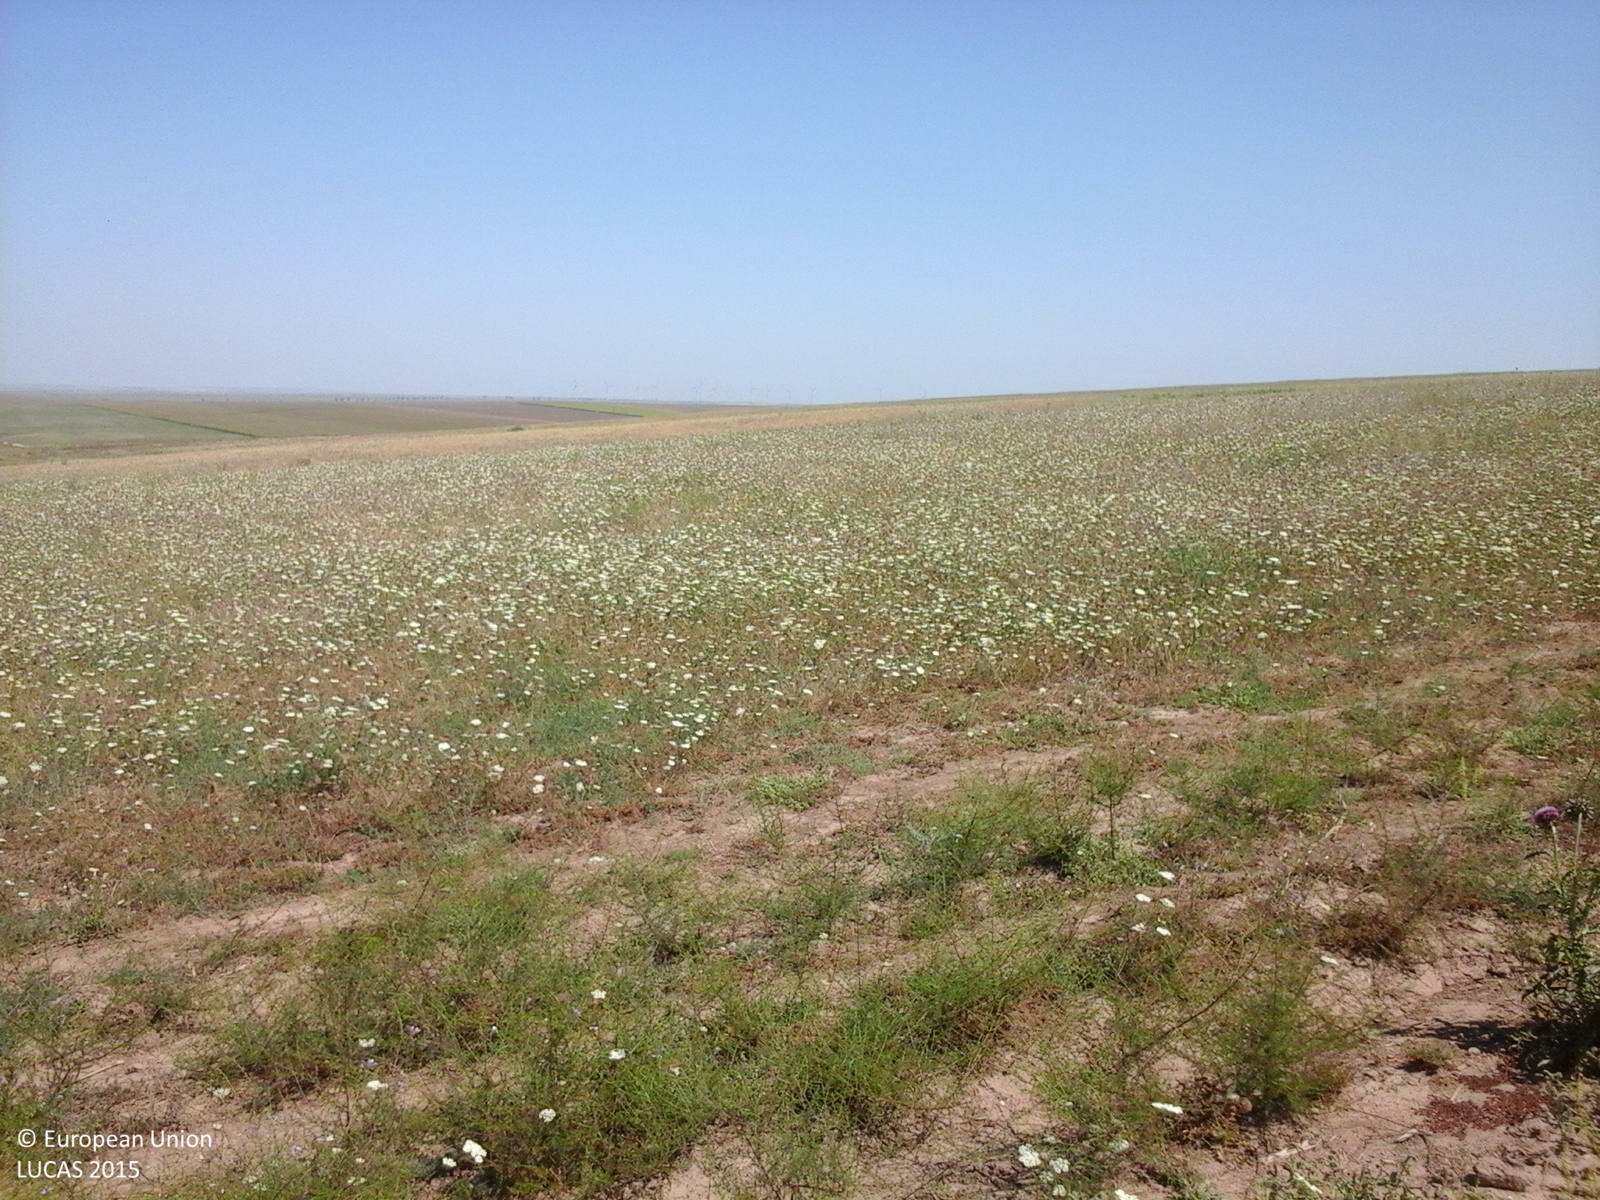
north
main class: Cropland
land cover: Sunflower
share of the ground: > 75 %
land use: Agriculture (excluding fallow land and kitchen gardens)
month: August
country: RO
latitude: 44.6856
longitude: 28.1699
